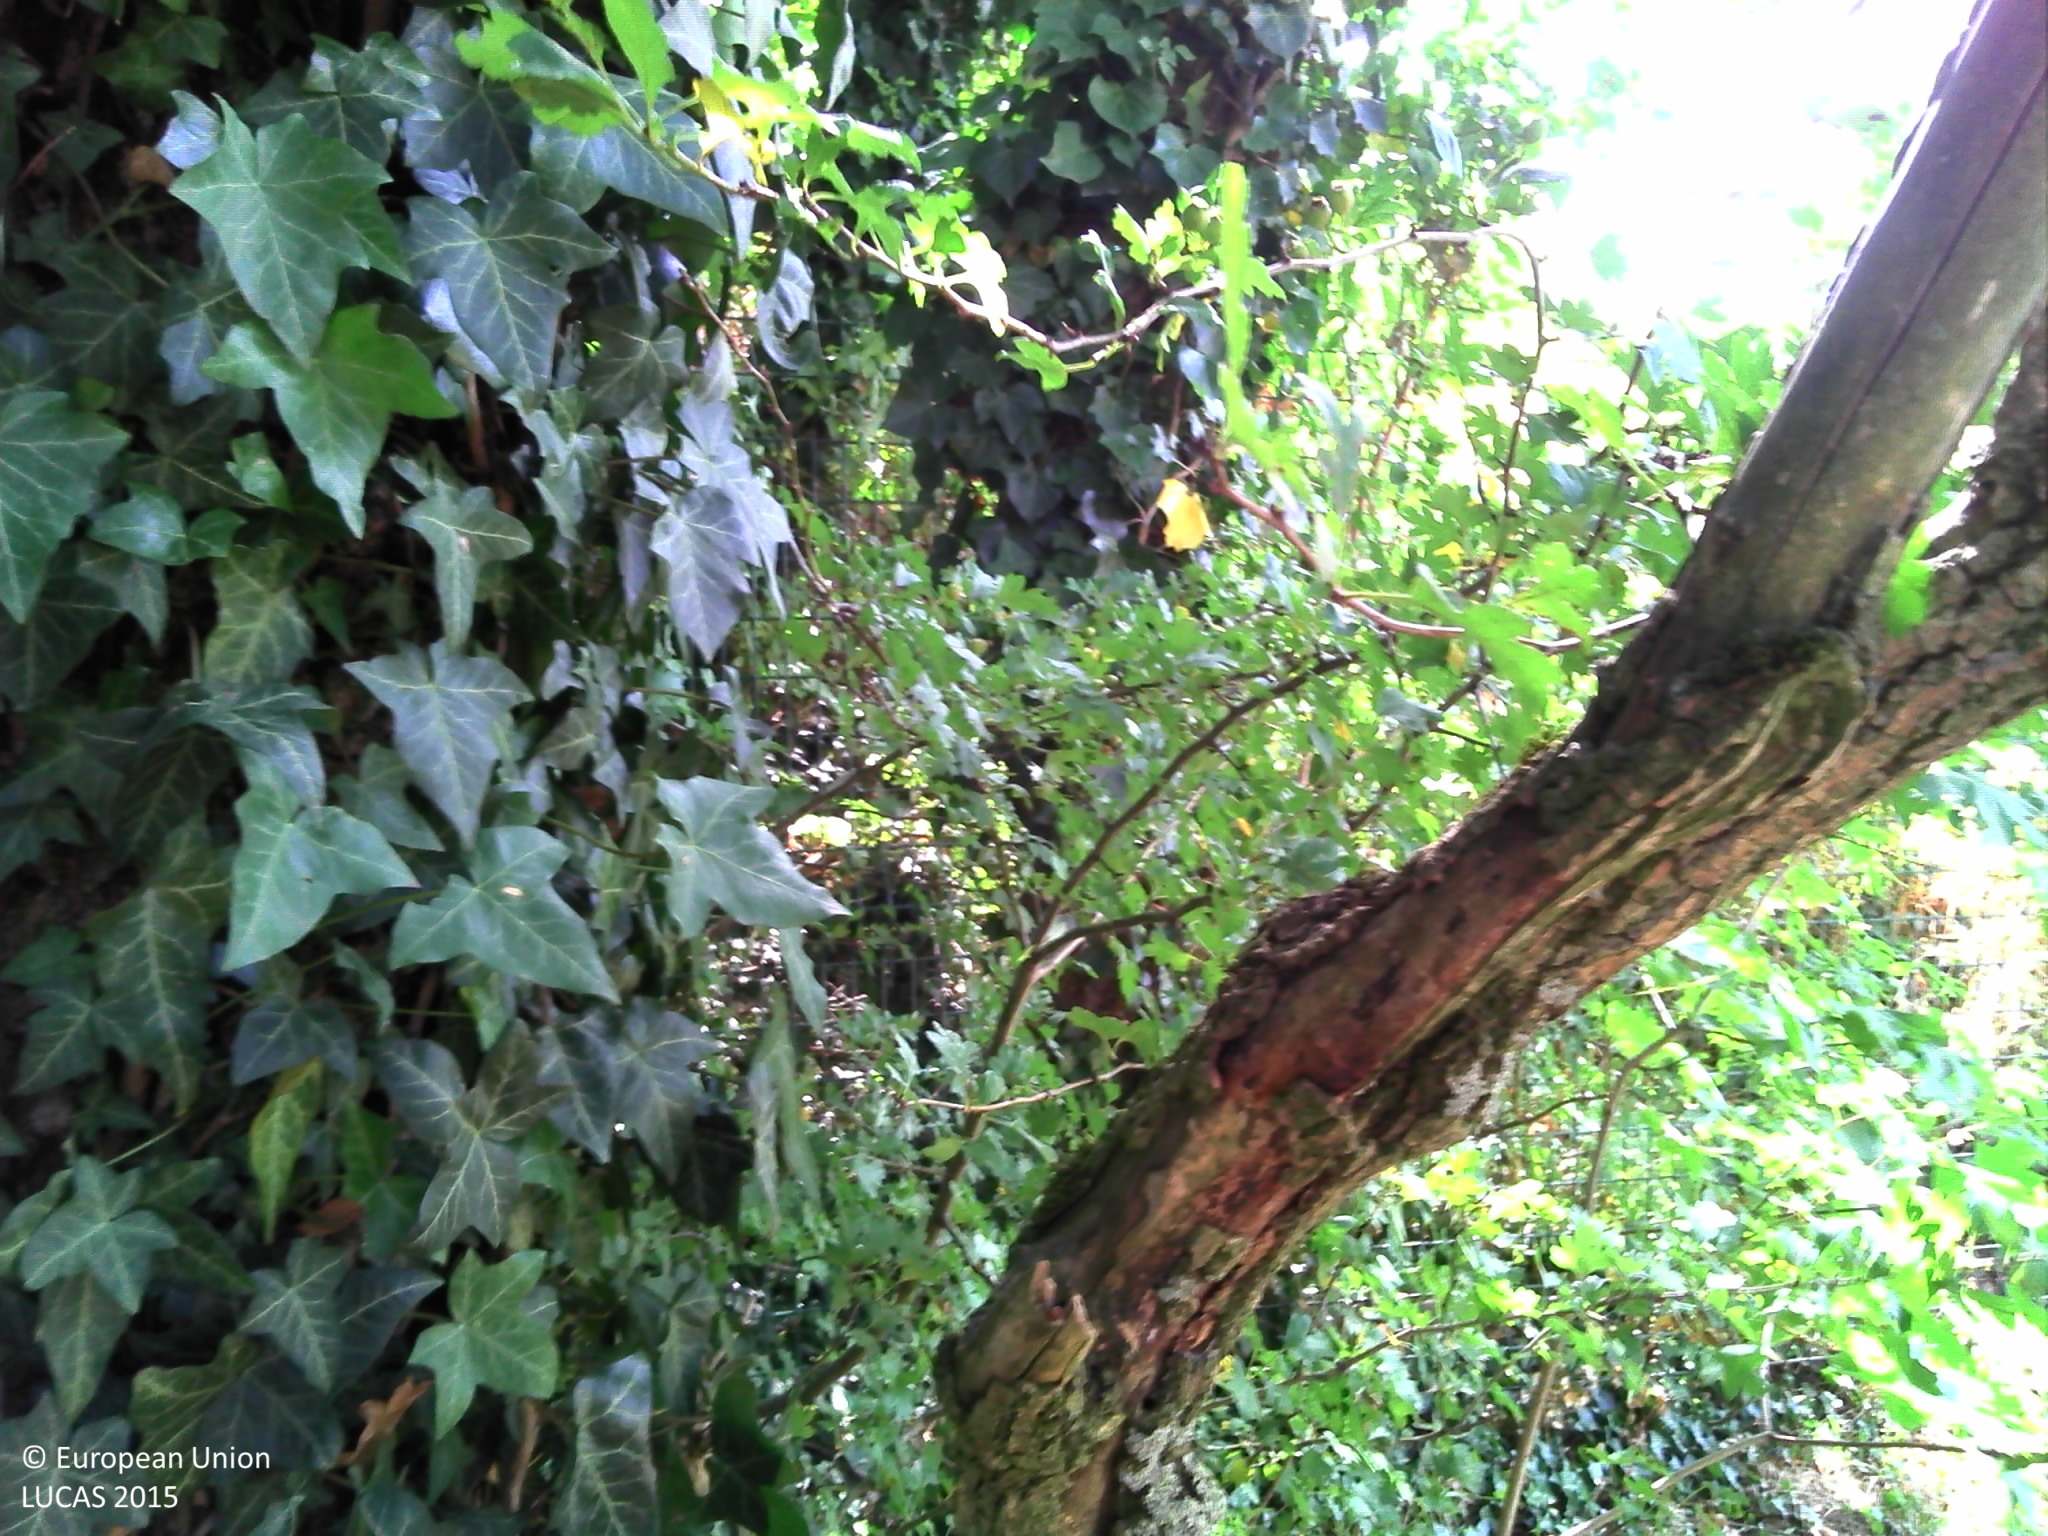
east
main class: Grassland
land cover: Grassland with sparse tree/shrub cover
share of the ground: > 75 %
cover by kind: herbaceous plants 95 %, broadleaved forest trees 5 %
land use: Amenities, museums, leisure
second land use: Residential
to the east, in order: Grassland with sparse tree/shrub cover; Fences; Abandoned hedges; Fences; Grassland with sparse tree/shrub cover; Artificial constructions in urban areas
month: August
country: FR
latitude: 47.7998
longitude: 3.5470
